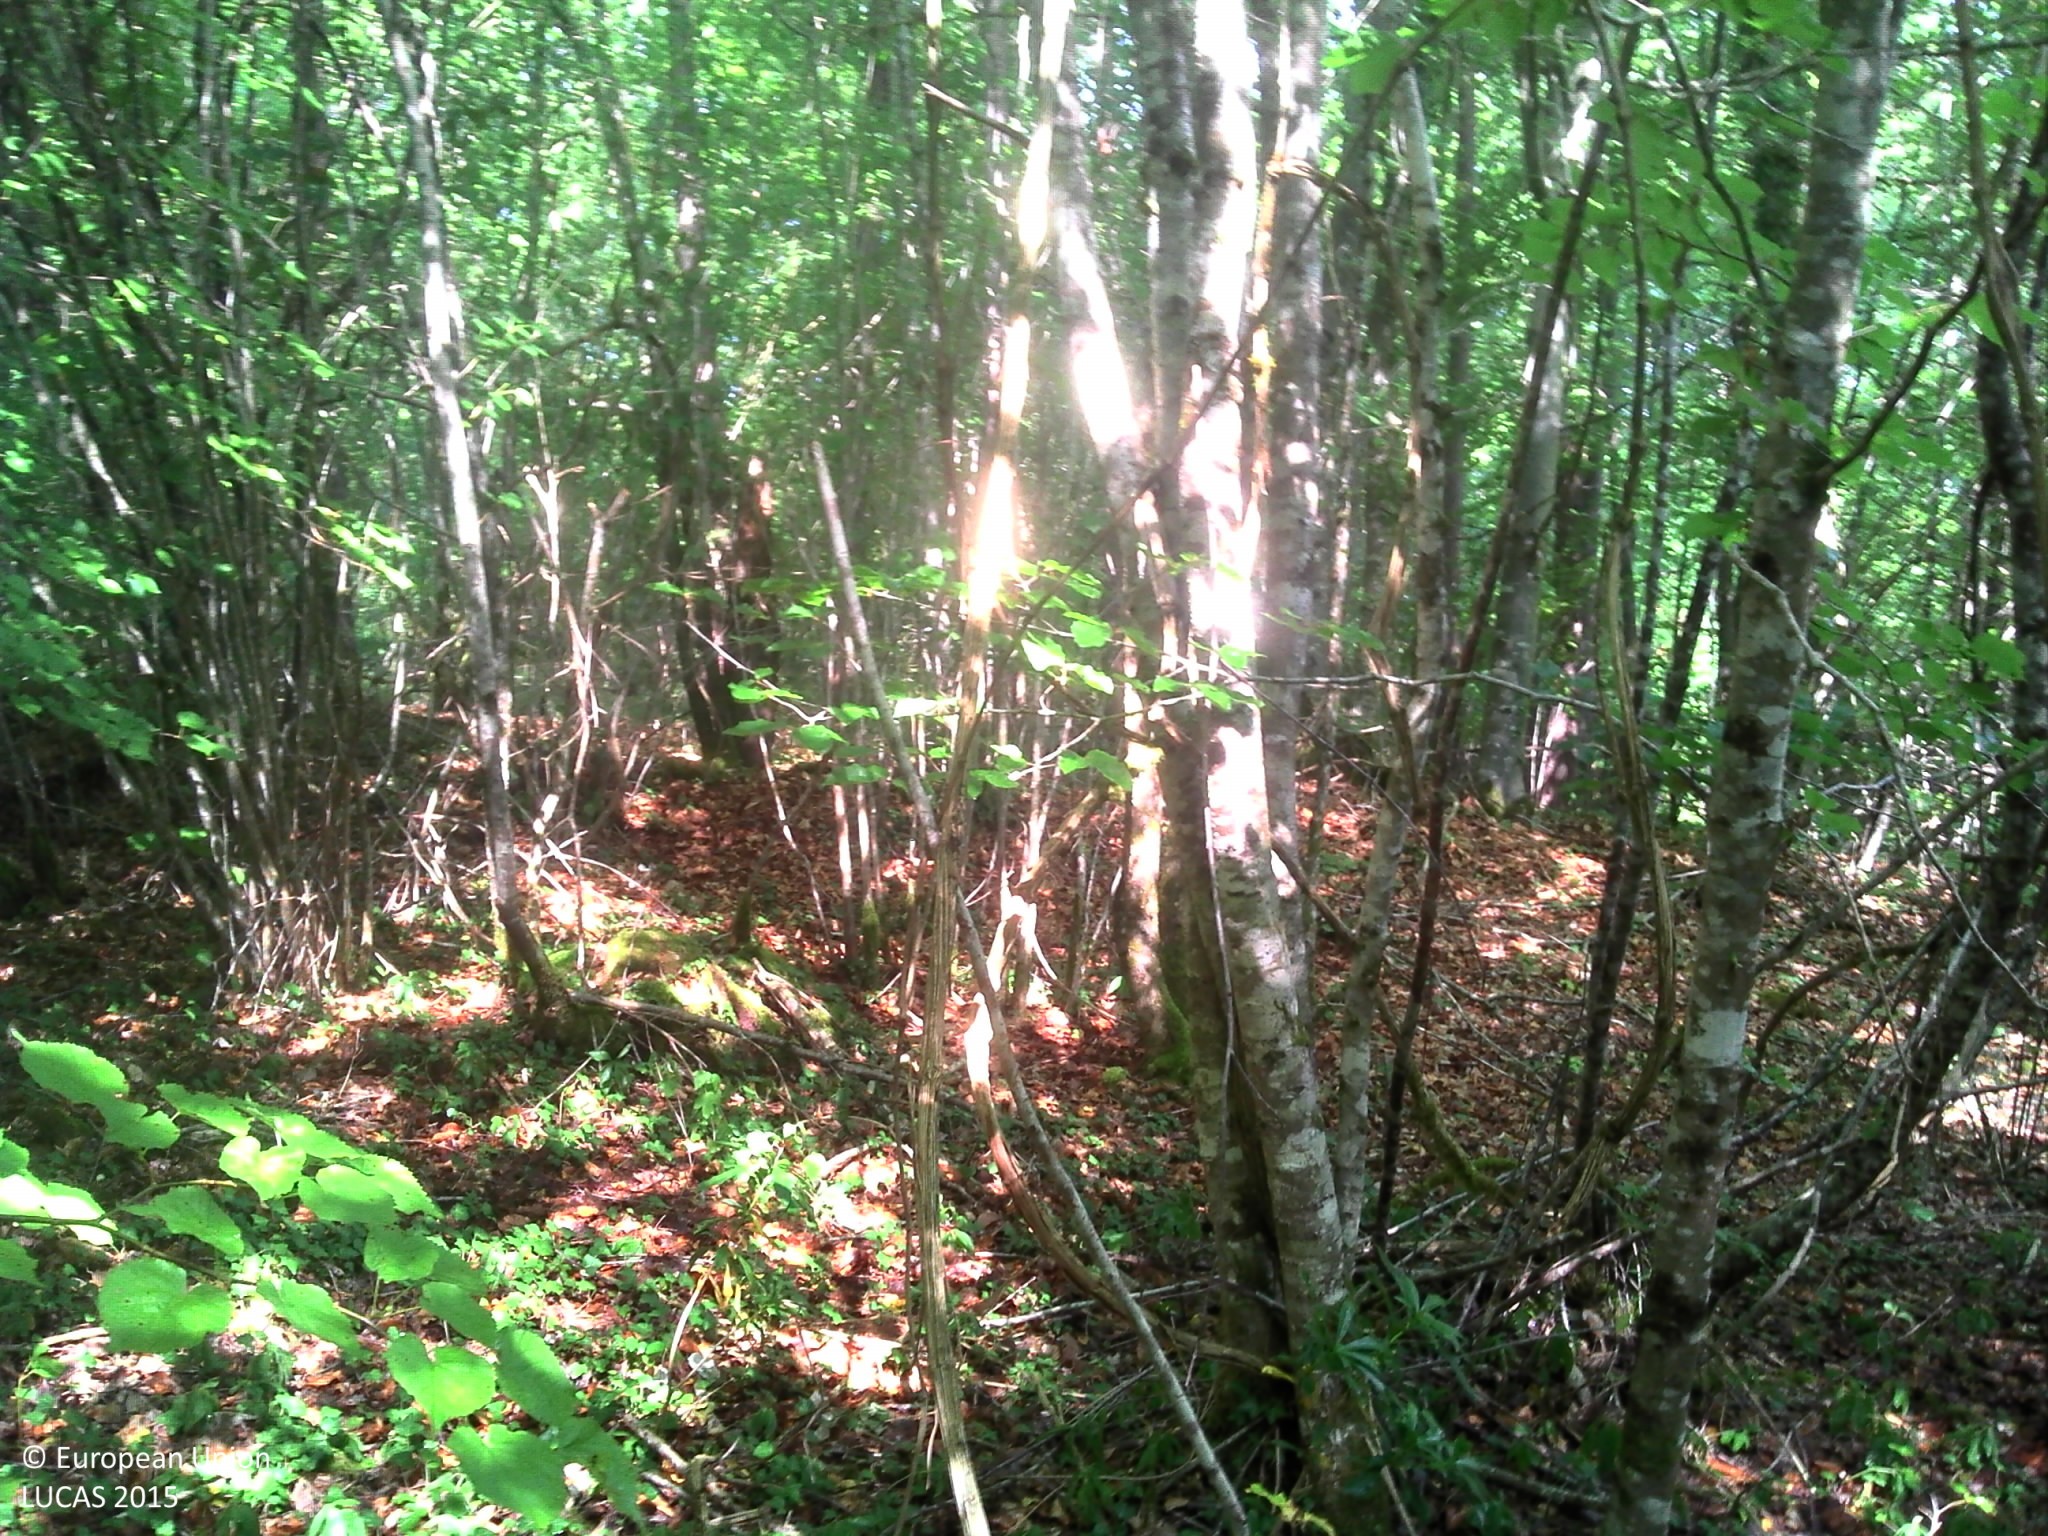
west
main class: Woodland
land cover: Broadleaved woodland
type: beech forest
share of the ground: > 75 %
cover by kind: broadleaved forest trees 85 %, coniferous forest trees 5 %, herbaceous plants 5 %, lichens and mosses 5 %
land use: Forestry
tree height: > 5 m
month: July
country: FR
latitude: 47.9958
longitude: 4.8661
